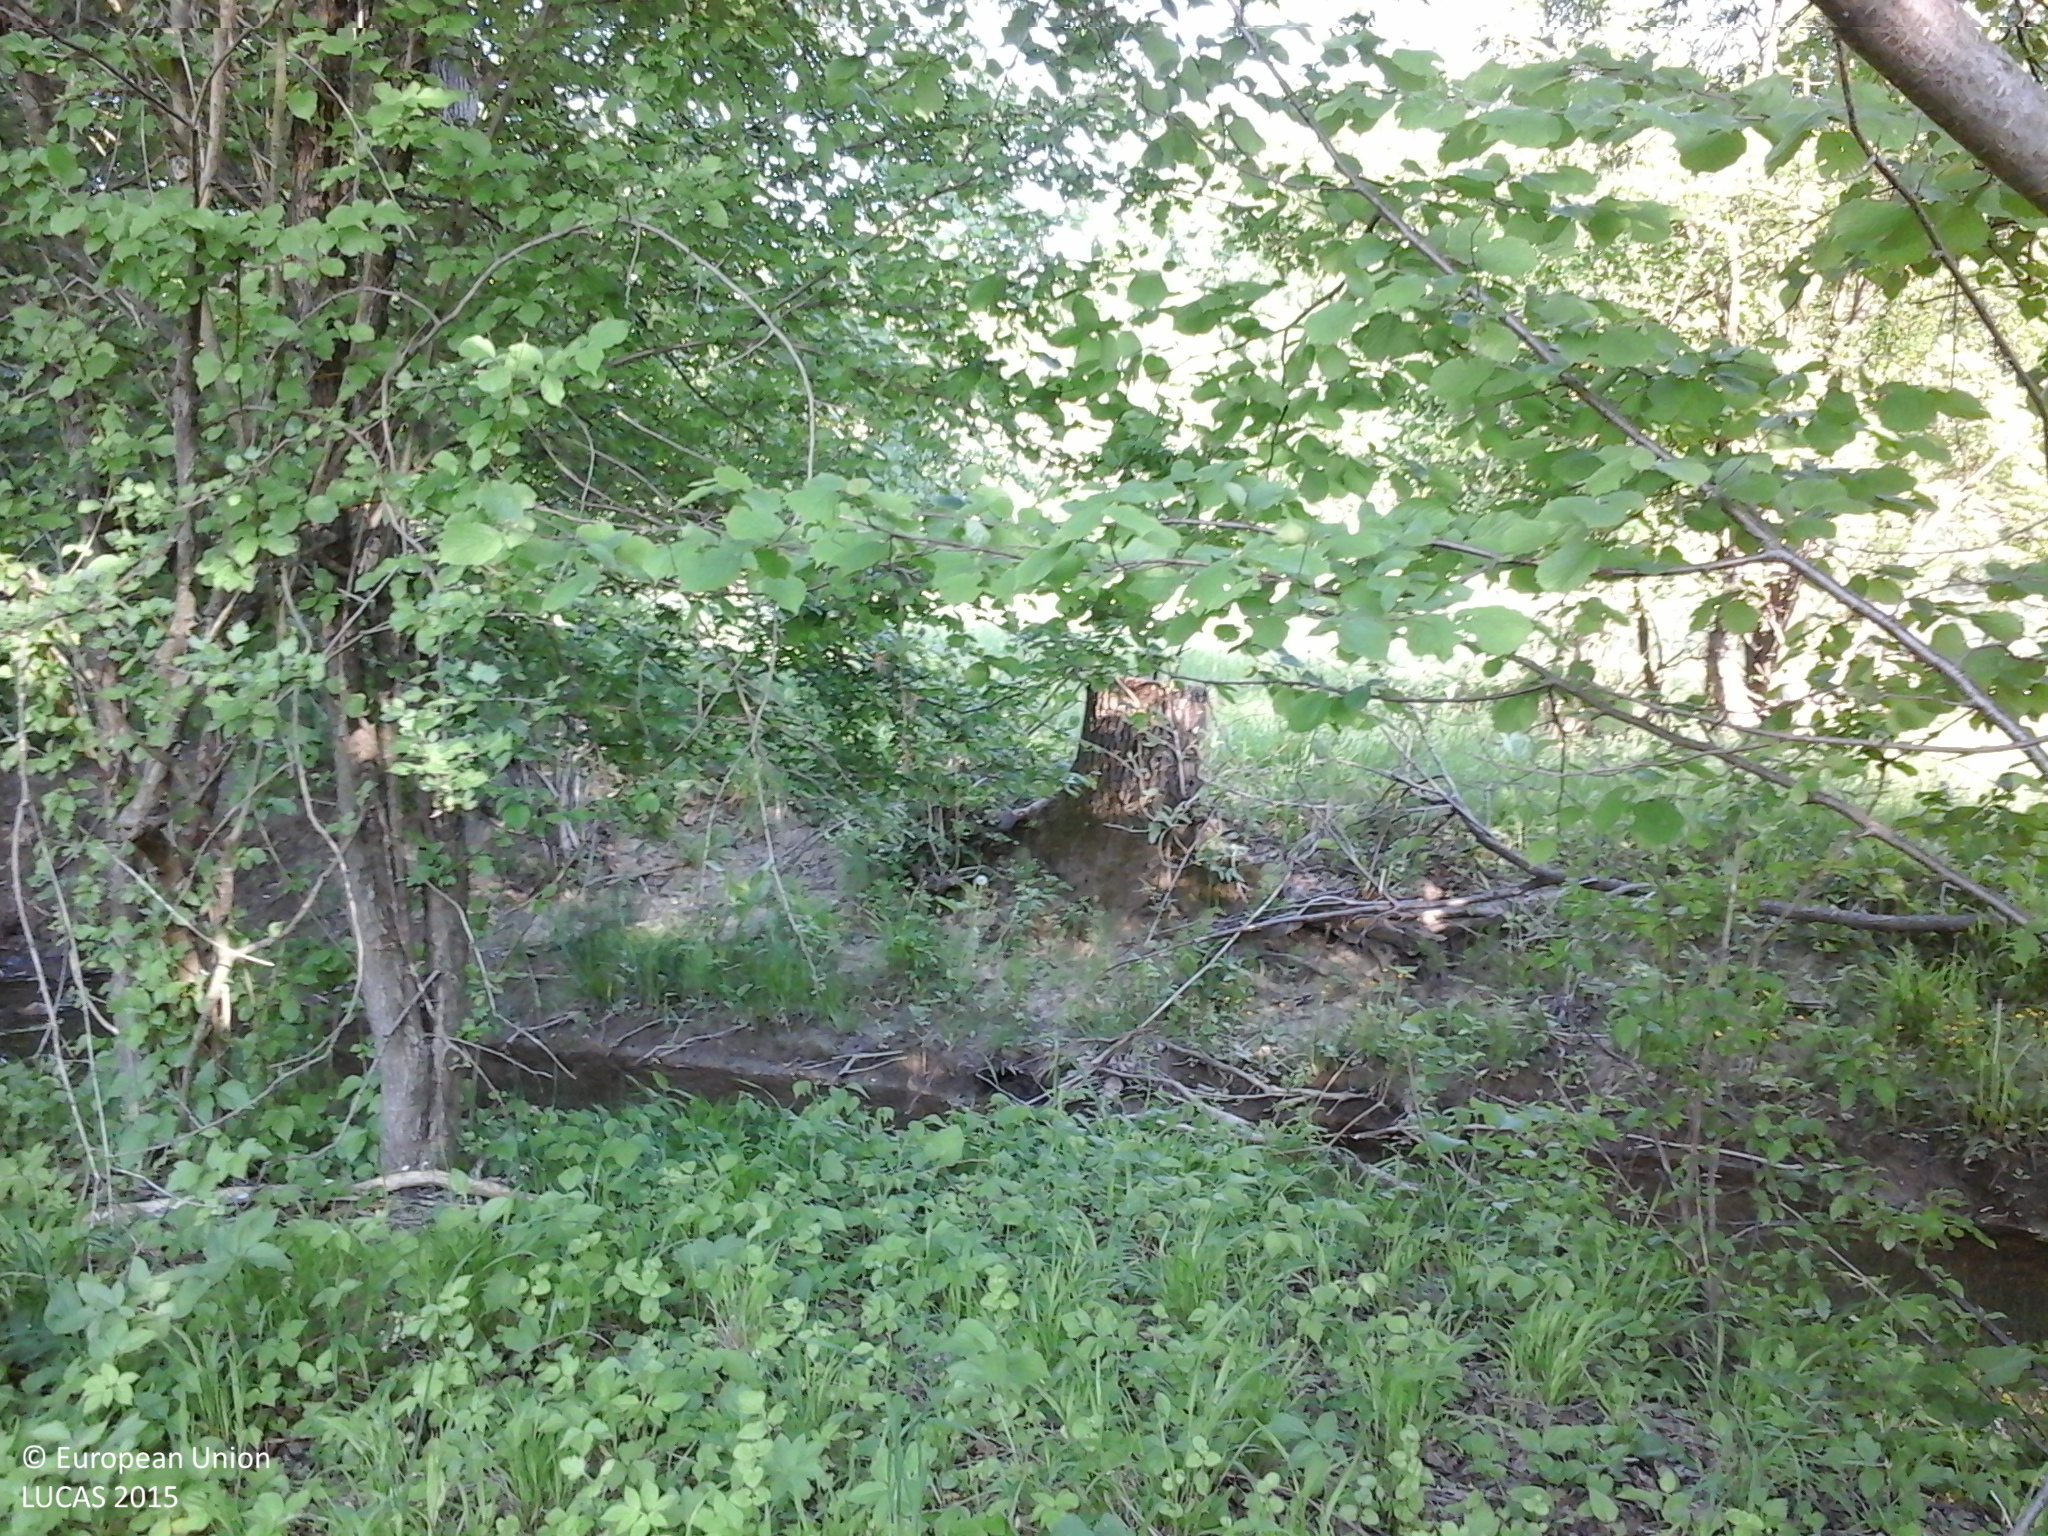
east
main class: Woodland
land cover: Other mixed woodland
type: non-riverine alder, birch or aspen forest
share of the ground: > 75 %
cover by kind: broadleaved forest trees 75 %, coniferous forest trees 25 %
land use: Forestry
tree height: > 5 m
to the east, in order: Other mixed woodland; Rivers and streams; Grassland without tree/shrub cover; Broadleaved woodland; Rivers and streams; Broadleaved woodland; Grassland without tree/shrub cover; Other fruit trees and berries; Artificial constructions in urban areas; Broadleaved woodland; Grassland without tree/shrub cover; Broadleaved woodland; Rivers and streams; Lines of trees; Grassland without tree/shrub cover
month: May
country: RO
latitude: 46.1911
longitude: 26.6561
